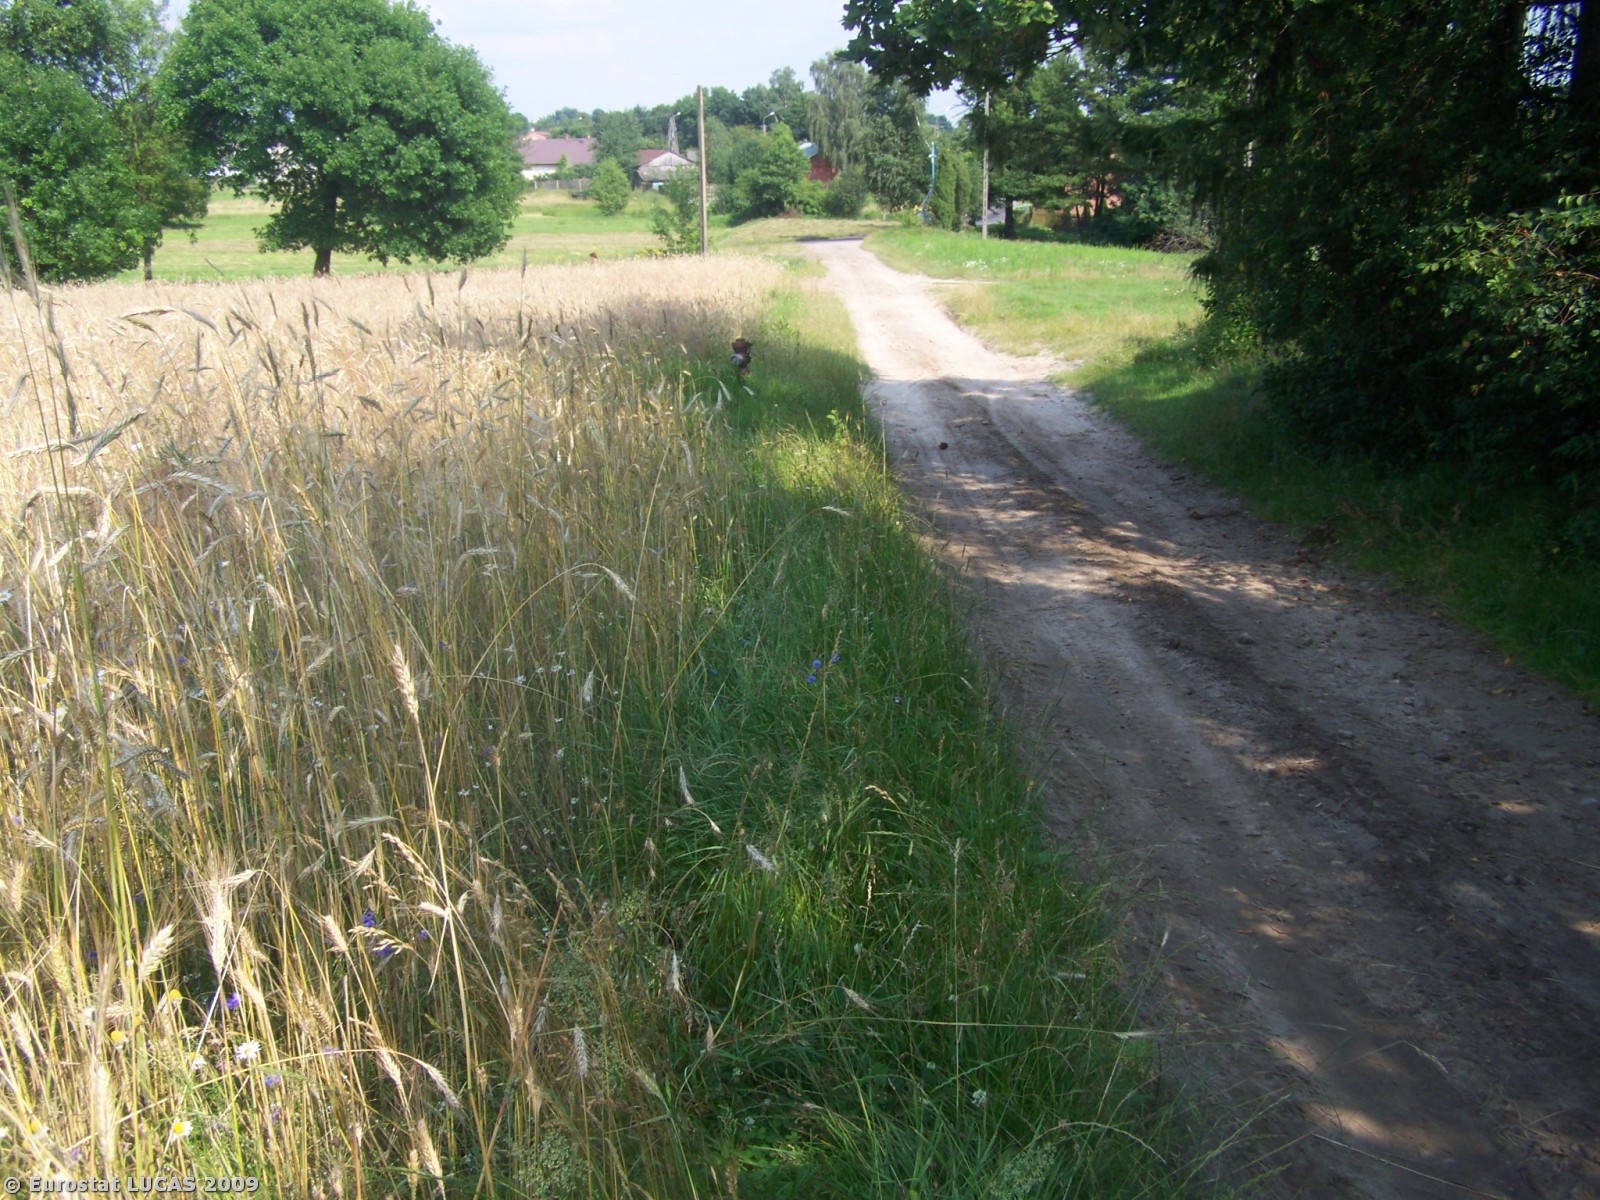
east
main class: Cropland
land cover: Rye
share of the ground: > 75 %
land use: Agriculture (excluding fallow land and kitchen gardens)
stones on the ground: < 10 %
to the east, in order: Rye; Grass margins; Tracks; Grassland without tree/shrub cover; Single bushes/trees; Grass margins; Paved roads, cycling and walking lanes; Grassland without tree/shrub cover; Ditches and canals; Grassland without tree/shrub cover; Tracks; Grassland without tree/shrub cover; Tracks; Grassland without tree/shrub cover; Grassland with sparse tree/shrub cover
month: July
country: PL
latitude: 52.0887
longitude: 21.6858
